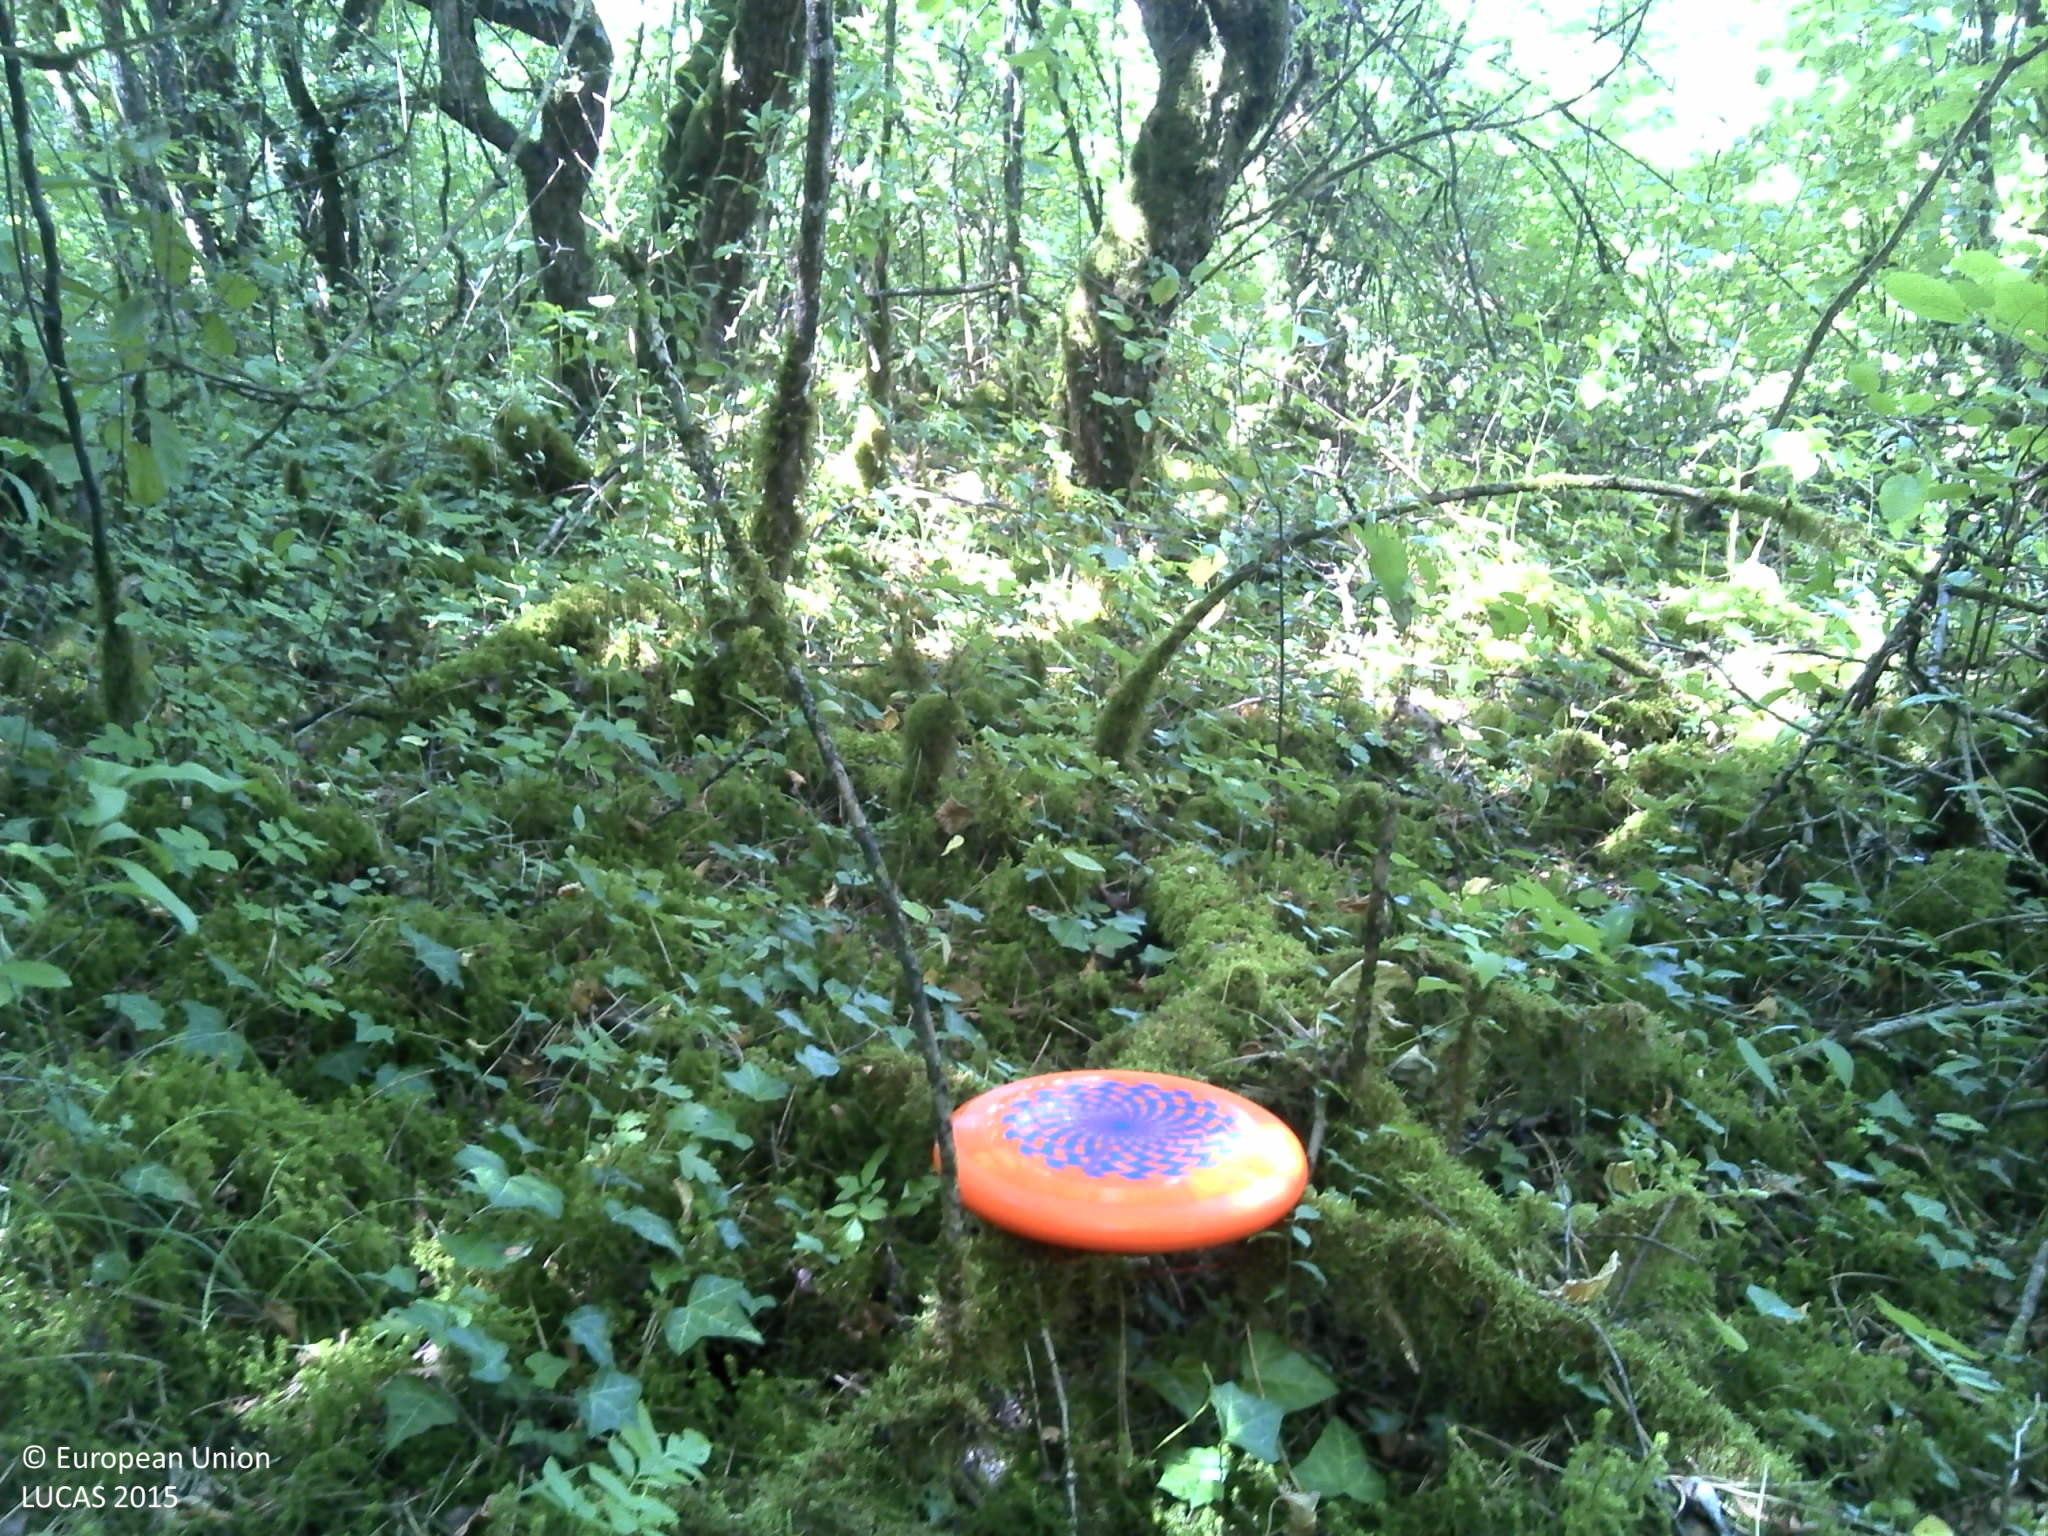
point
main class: Woodland
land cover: Broadleaved woodland
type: mesophytic deciduous forest
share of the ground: > 75 %
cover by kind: broadleaved forest trees 90 %, coniferous forest trees 5 %, herbaceous plants 5 %
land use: Semi-natural and natural areas not in use
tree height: > 5 m
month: August
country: FR
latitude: 48.9121
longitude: 4.7988
